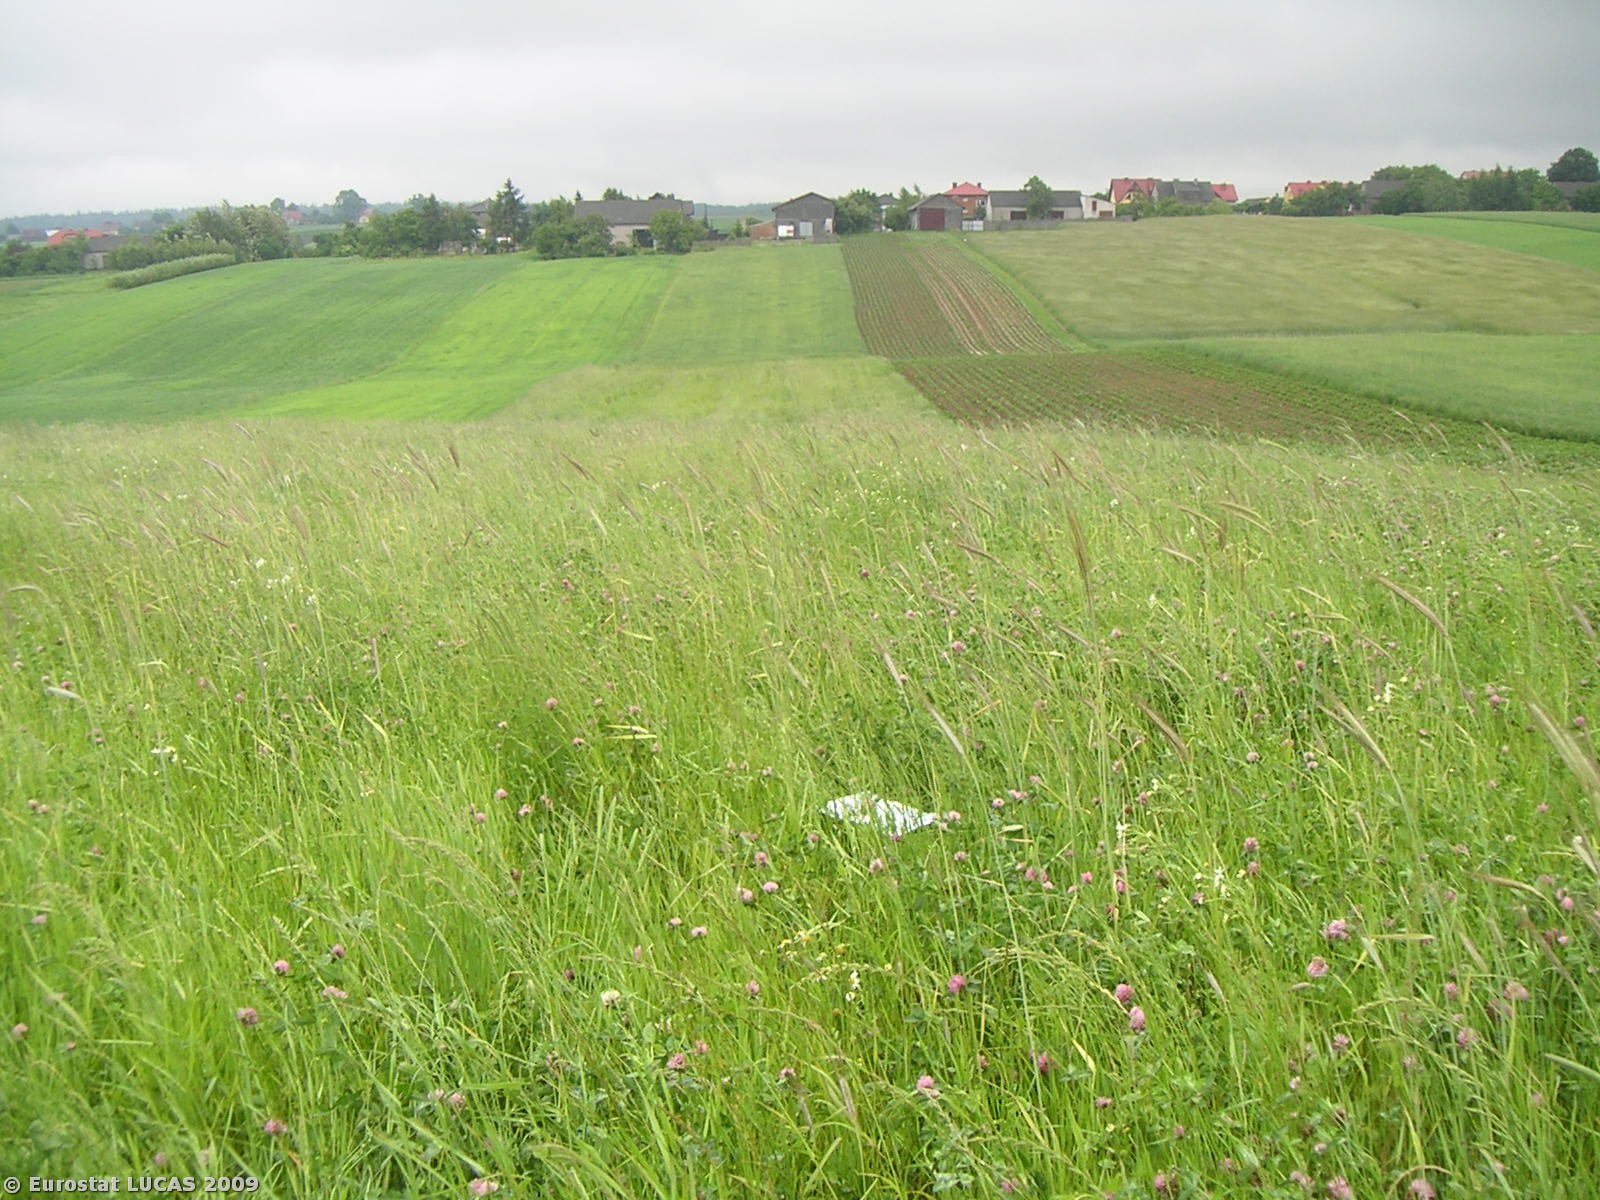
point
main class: Cropland
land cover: Clovers
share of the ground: 10 - 25 %
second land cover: Grassland without tree/shrub cover
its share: 25 - 50 %
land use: Agriculture (excluding fallow land and kitchen gardens)
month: June
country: PL
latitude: 50.2700
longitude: 19.7811
